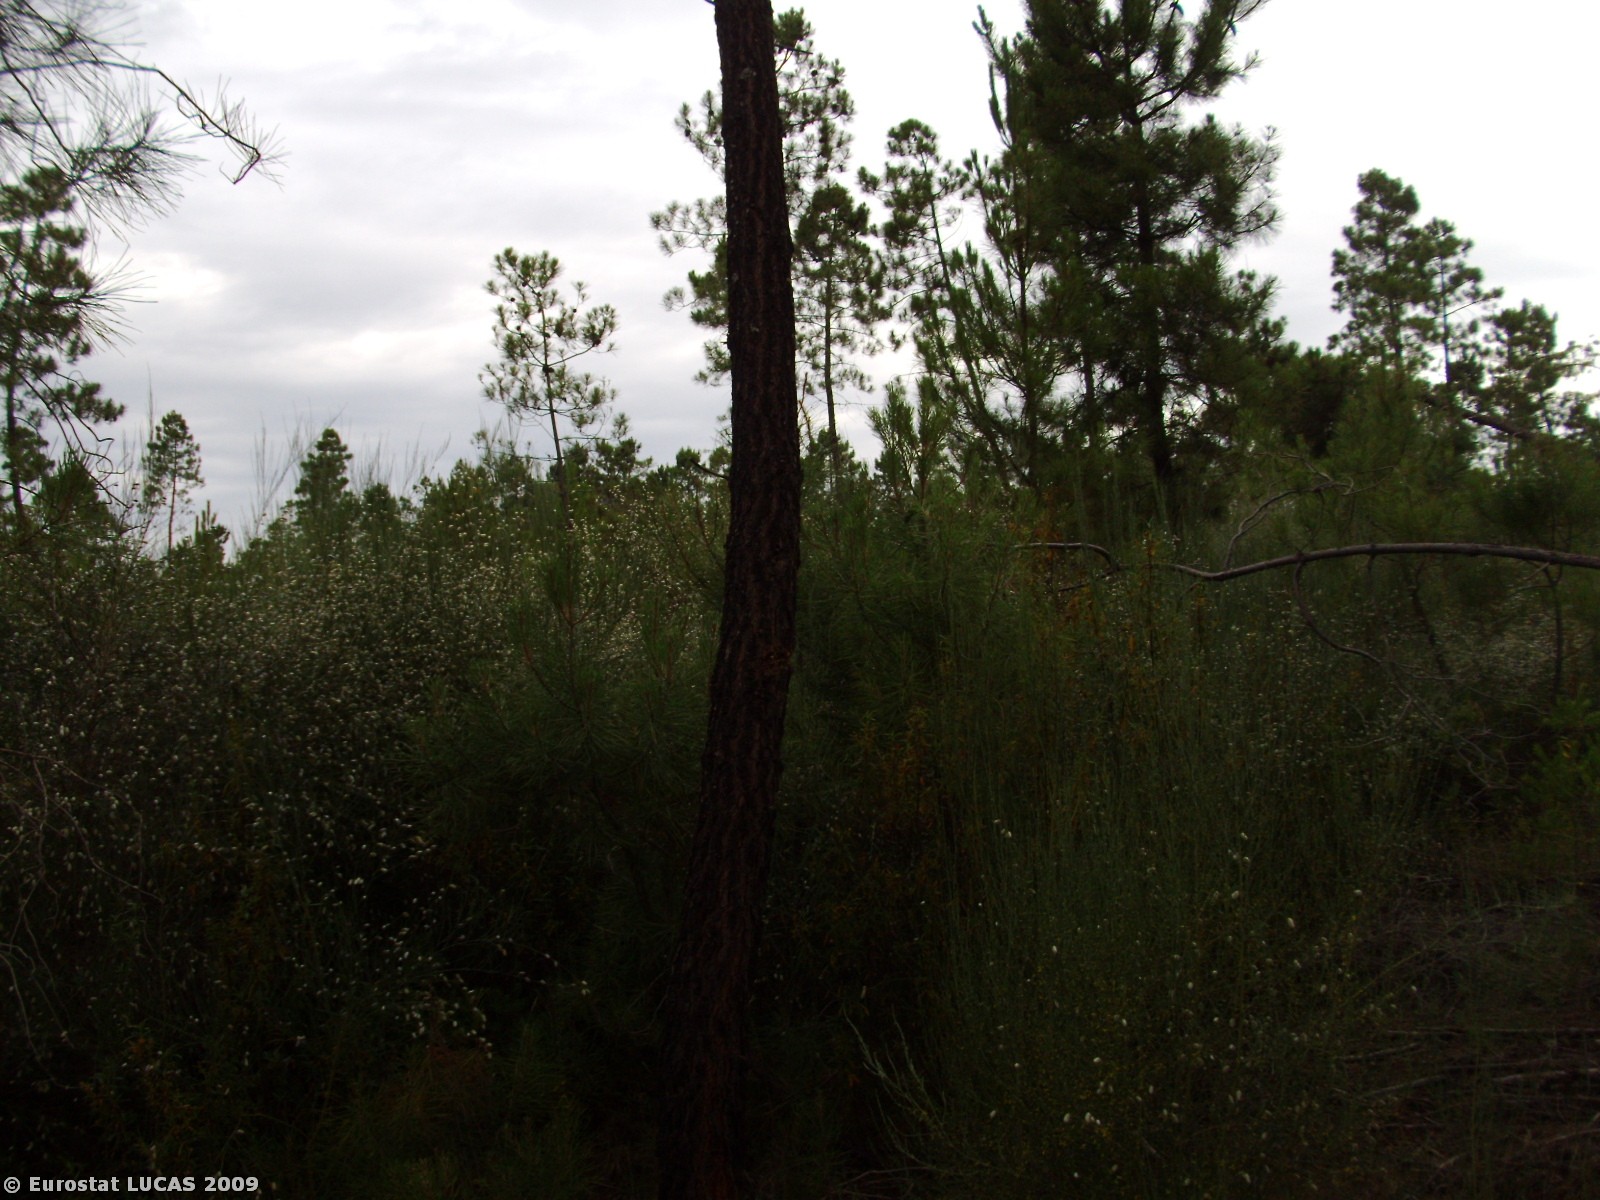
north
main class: Woodland
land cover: Coniferous woodland
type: coniferous forest of the mediterranean region
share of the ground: > 75 %
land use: Forestry
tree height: > 5 m
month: June
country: PT
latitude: 39.9312
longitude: -7.5253
